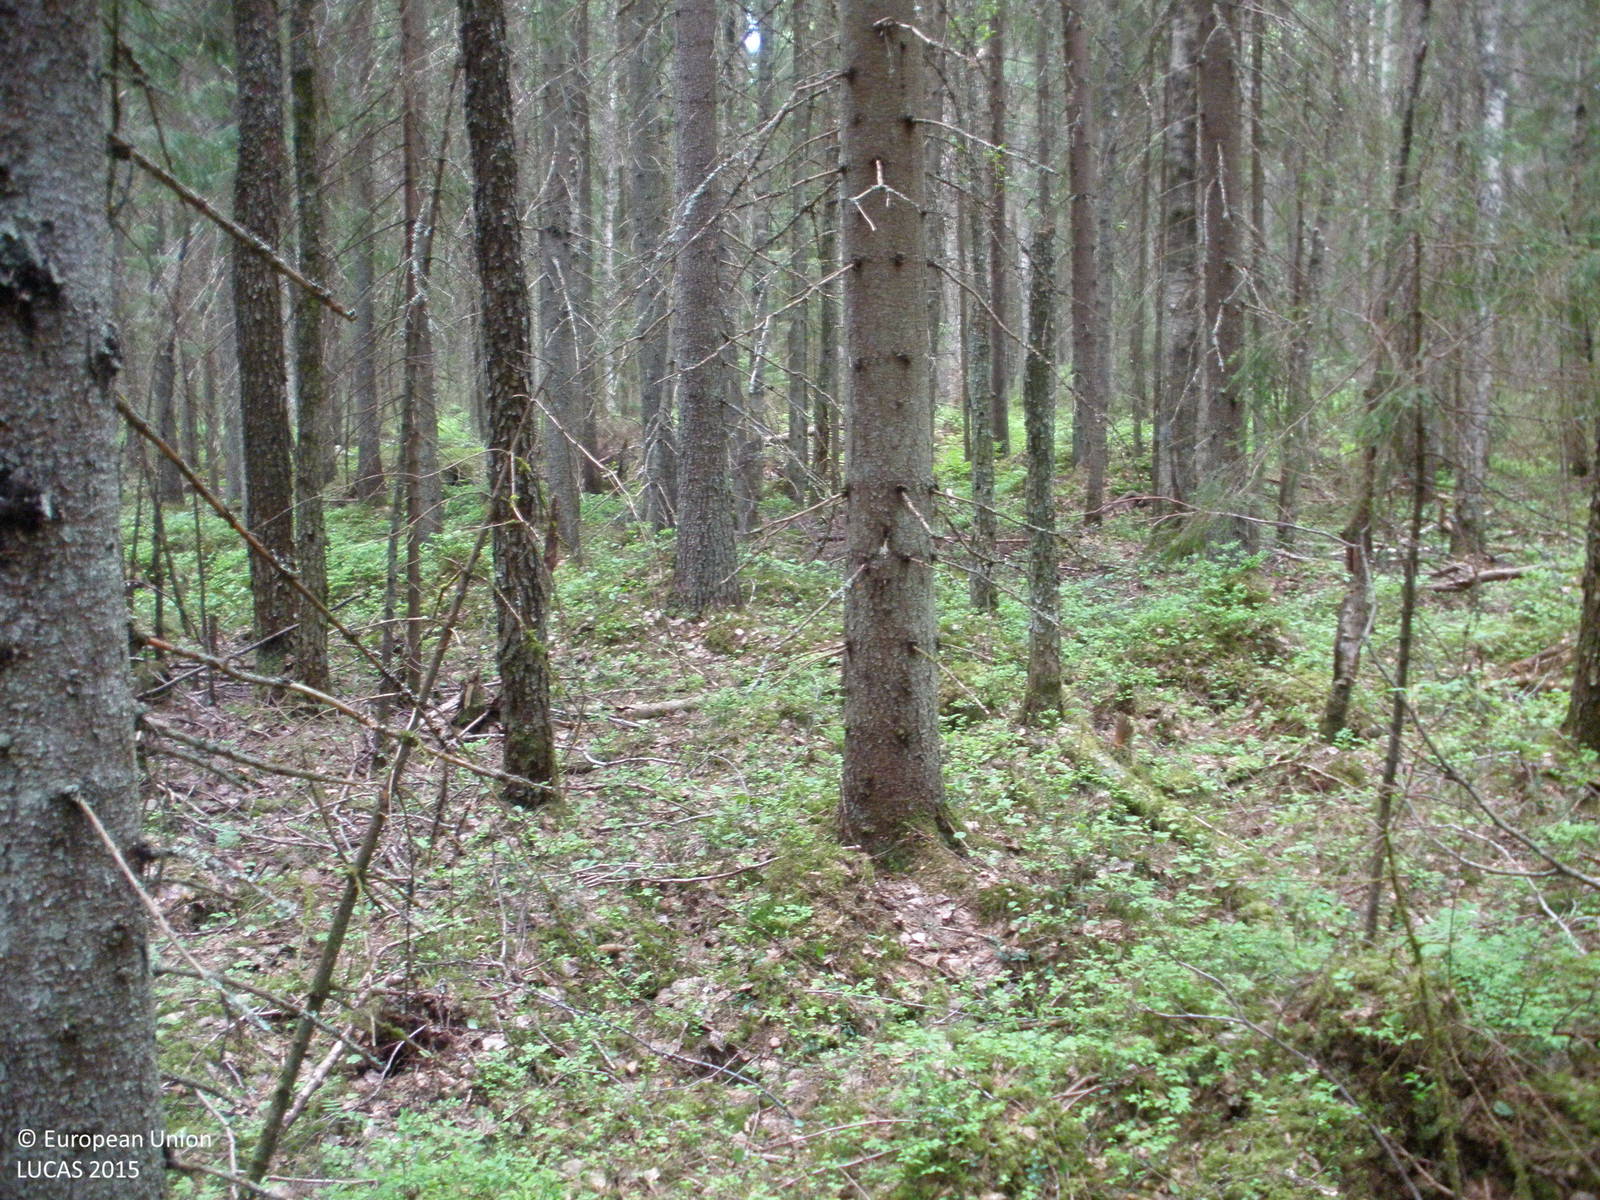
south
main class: Woodland
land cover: Spruce dominated mixed woodland
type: boreal forest
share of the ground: > 75 %
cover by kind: coniferous forest trees 65 %, broadleaved forest trees 25 %, shrubs 5 %, herbaceous plants 5 %
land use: Forestry
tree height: > 5 m
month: June
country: FI
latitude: 60.7234
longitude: 24.0084
